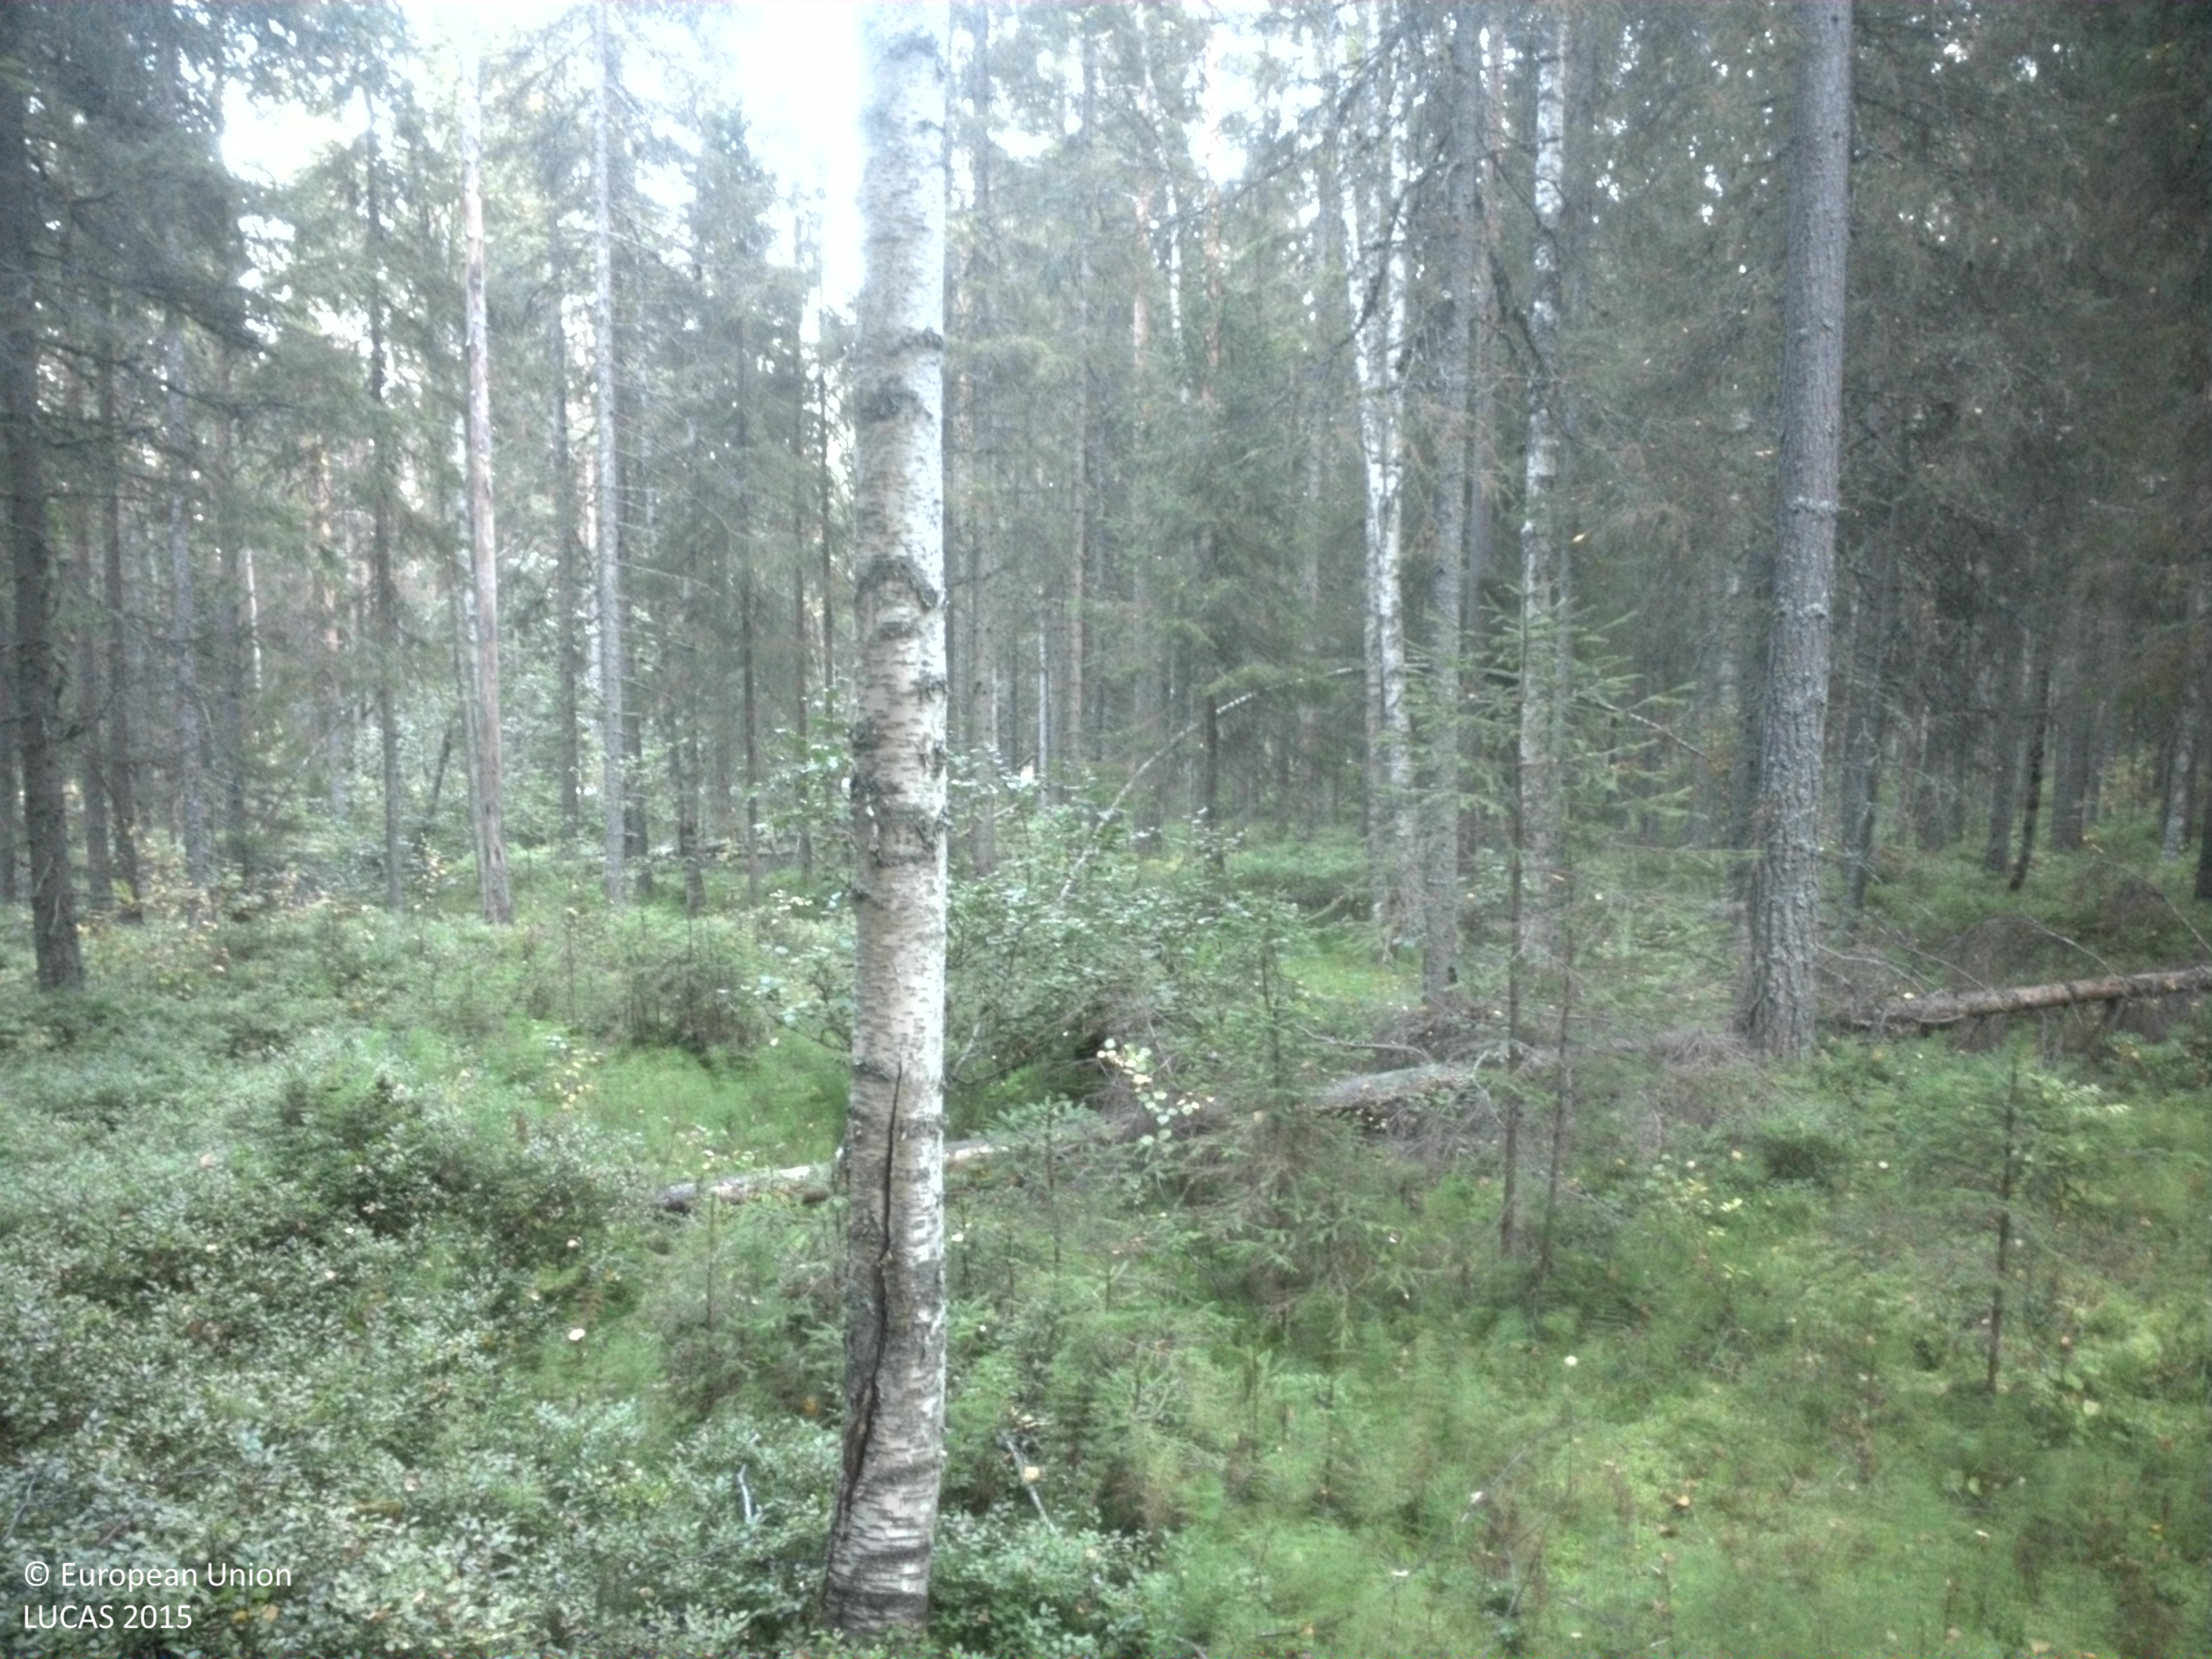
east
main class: Woodland
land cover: Spruce dominated coniferous woodland
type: boreal forest
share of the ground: 50 - 75 %
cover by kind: coniferous forest trees 75 %, shrubs 25 %
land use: Forestry
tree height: > 5 m
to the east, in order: Spruce dominated coniferous woodland; Spruce dominated mixed woodland; Other coniferous woodland; Shrubland without tree cover; Electric lines; Ditches and canals; Grassland without tree/shrub cover; Paved roads, cycling and walking lanes; Grassland without tree/shrub cover; Other coniferous woodland; Ditches and canals; Spruce dominated mixed woodland; Ditches and canals; Other mixed woodland; Spruce dominated coniferous woodland
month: September
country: SE
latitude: 64.3402
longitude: 20.5140
